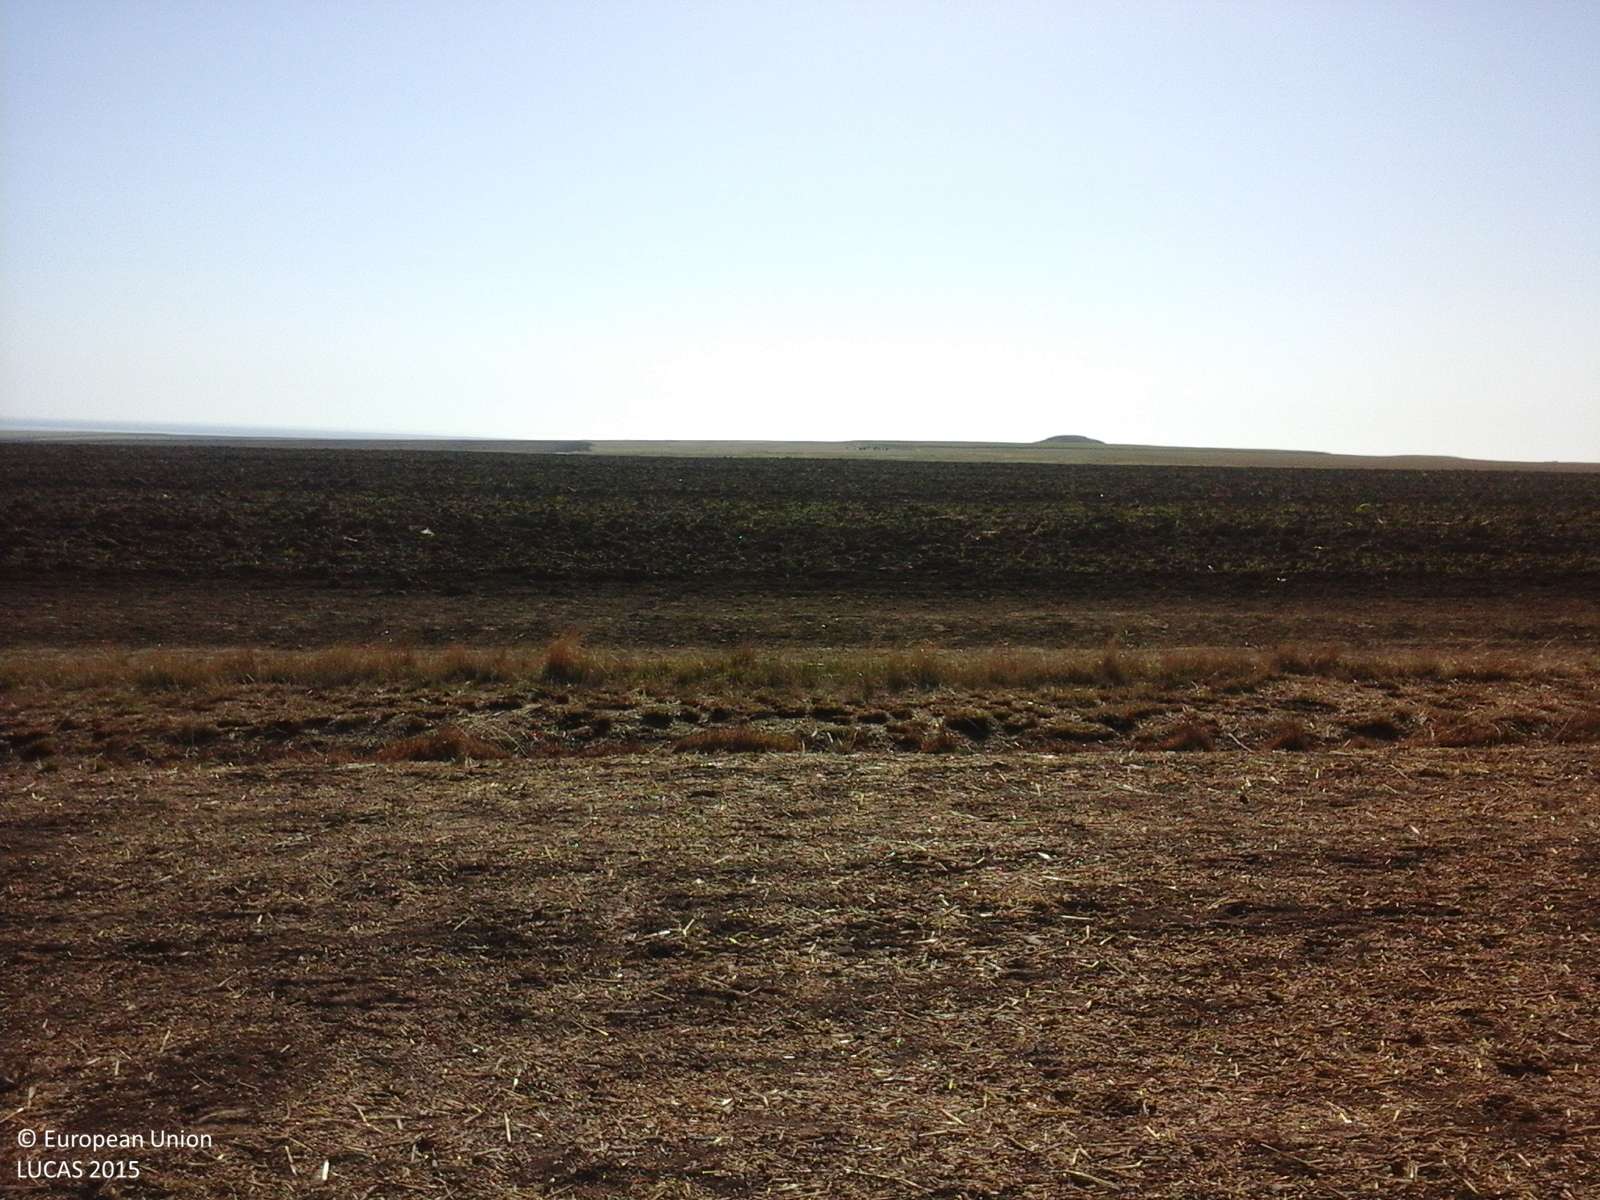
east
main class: Cropland
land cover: Common wheat
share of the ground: < 10 %
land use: Agriculture (excluding fallow land and kitchen gardens)
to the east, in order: Common wheat; Grass margins; Tracks; Other bare soil; Grassland without tree/shrub cover
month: August
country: RO
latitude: 44.4667
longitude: 28.6691
